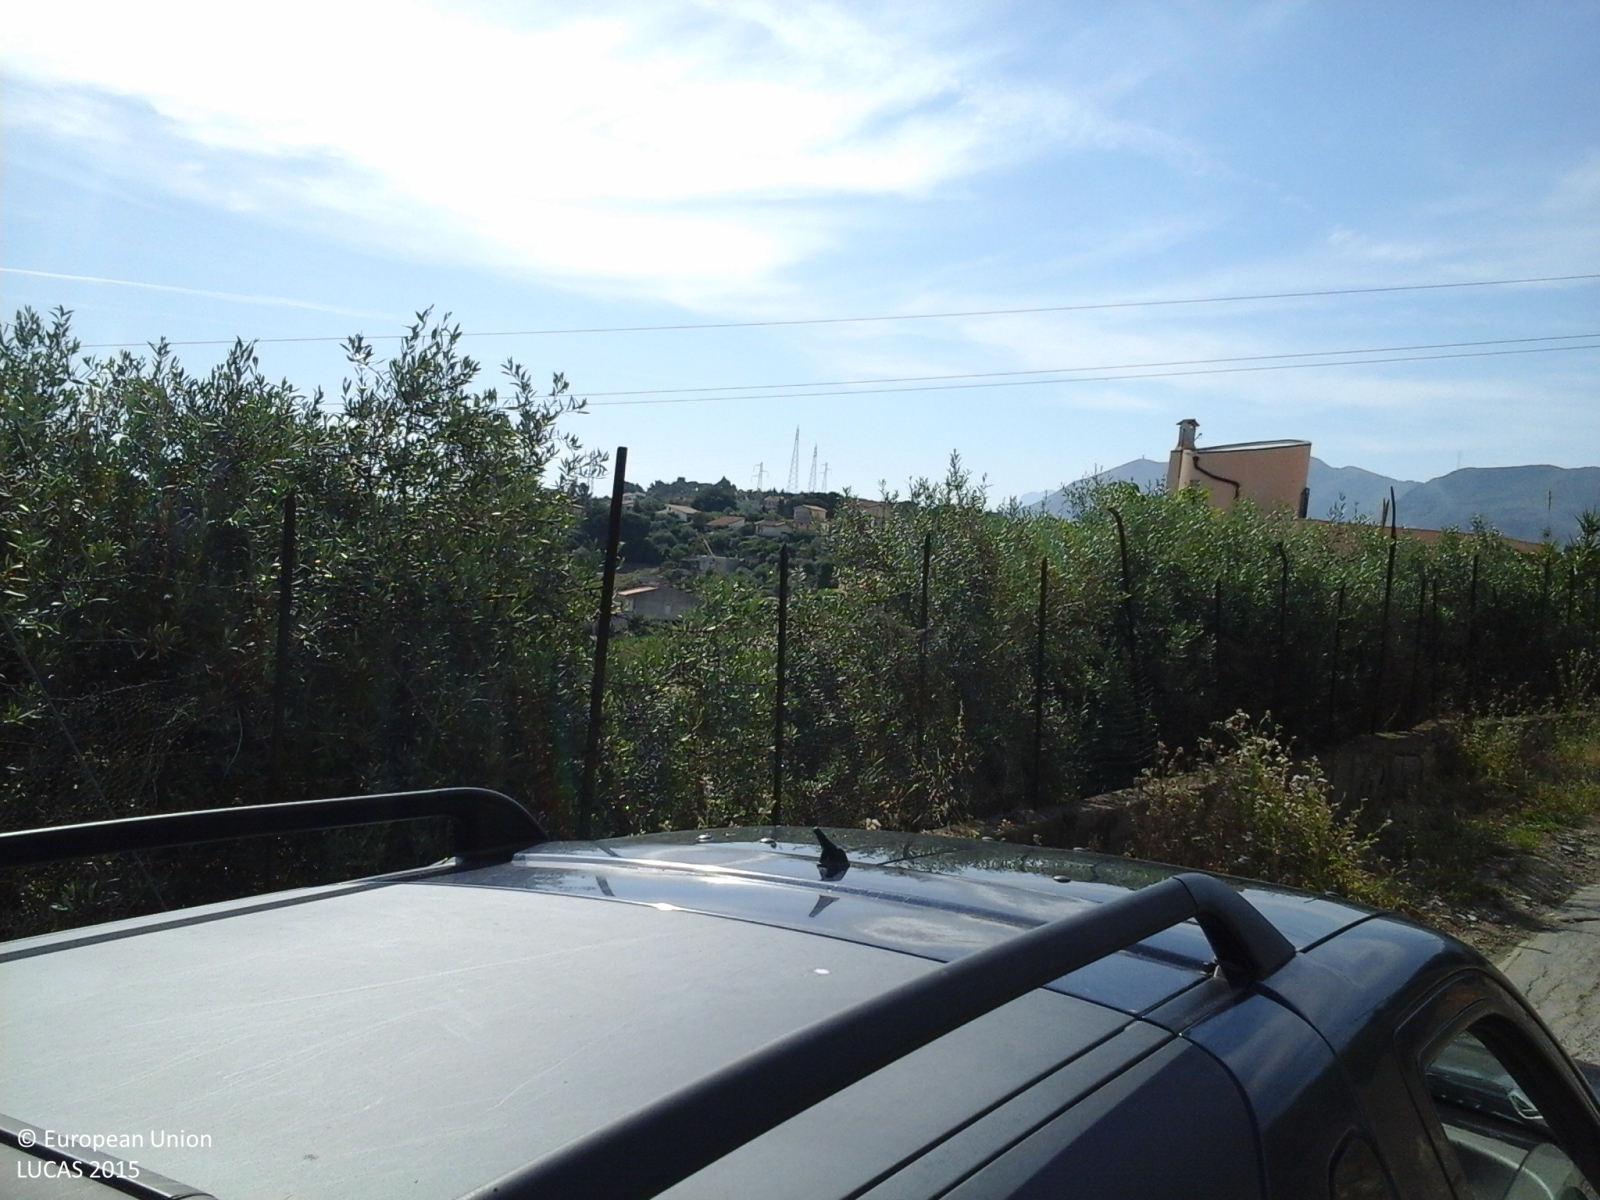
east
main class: Cropland
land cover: Olive groves
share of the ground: 50 - 75 %
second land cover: Spontaneously vegetated surfaces
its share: > 75 %
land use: Agriculture (excluding fallow land and kitchen gardens)
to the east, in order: Olive groves; Spontaneously vegetated surfaces; Artificial constructions in urban areas; Olive groves; Electric lines; Olive groves; Artificial constructions in urban areas; Grass margins; Other fresh vegetables; Spontaneously vegetated surfaces; Vineyards; Olive groves; Vineyards; Fences; Tracks; Other fresh vegetables; Fences; Grass margins
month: May
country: IT
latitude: 38.0466
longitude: 13.4965
